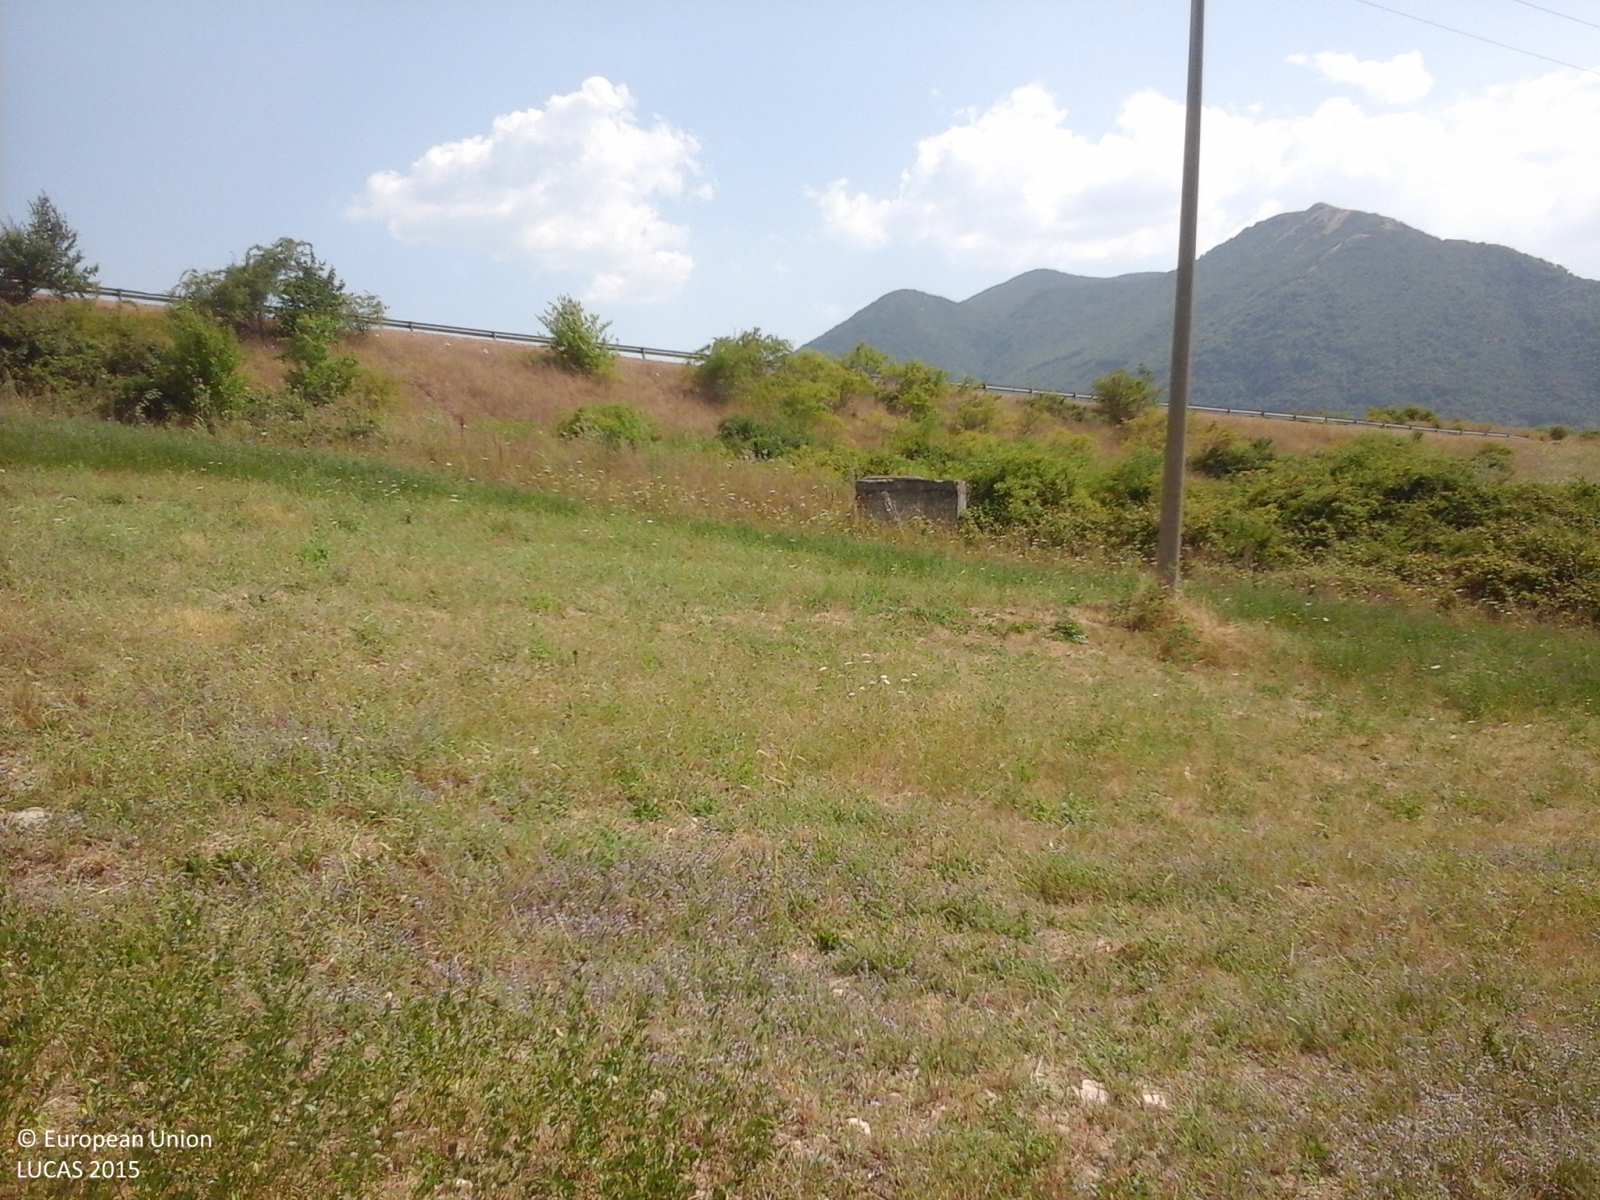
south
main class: Cropland
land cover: Lucerne
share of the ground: > 75 %
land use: Agriculture (excluding fallow land and kitchen gardens)
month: July
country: IT
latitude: 40.8757
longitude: 15.1418
